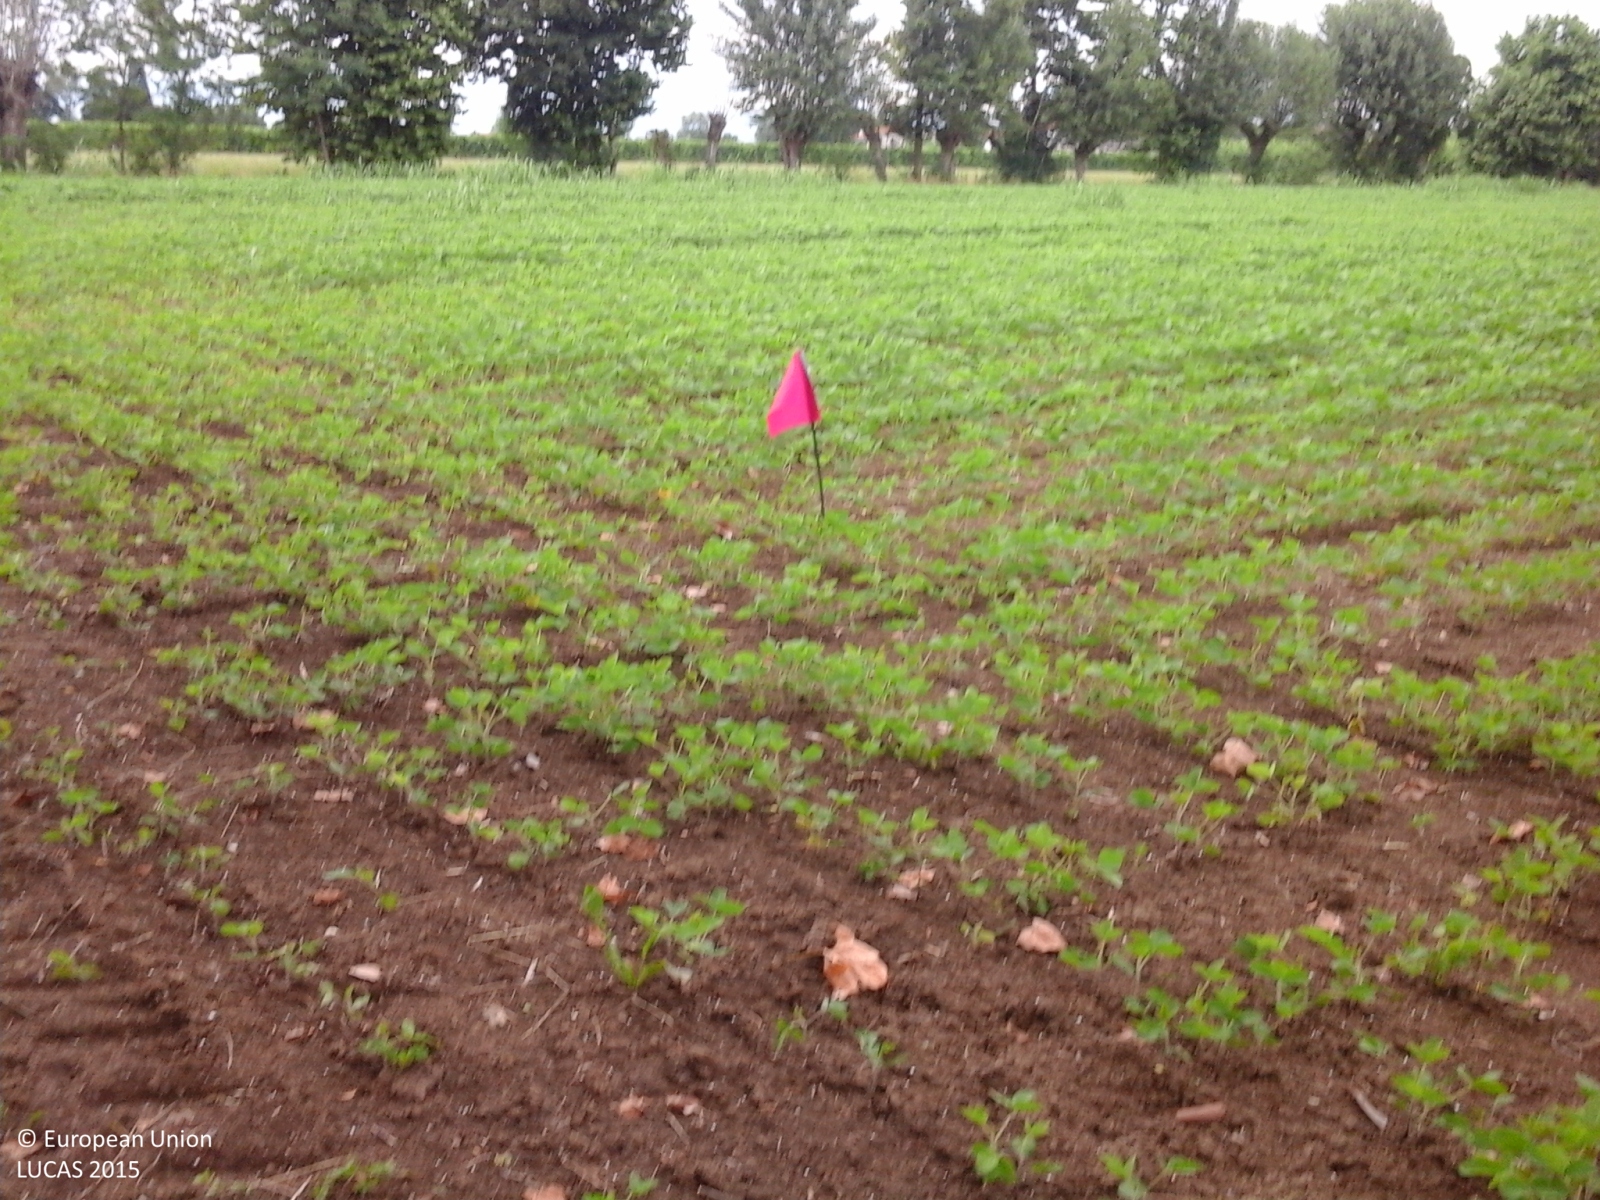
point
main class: Cropland
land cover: Soya
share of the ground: 50 - 75 %
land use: Agriculture (excluding fallow land and kitchen gardens)
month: June
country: IT
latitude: 45.7986
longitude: 12.5311
